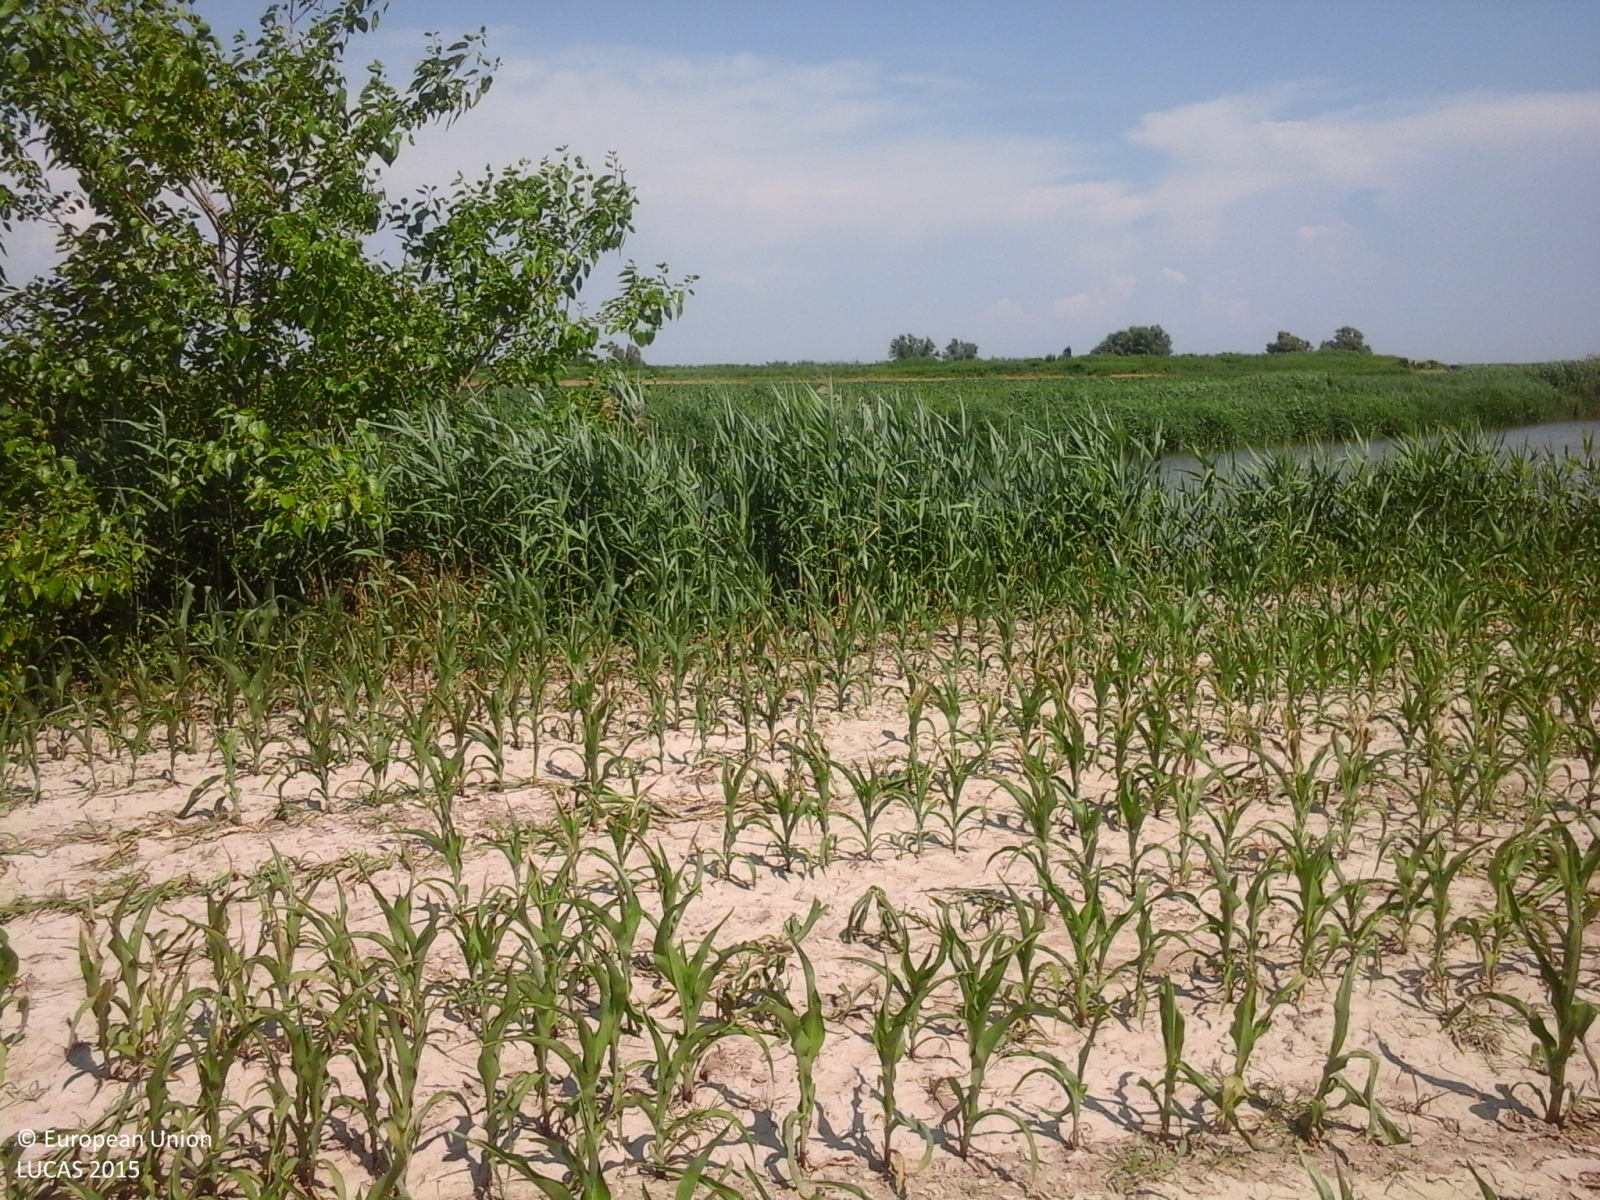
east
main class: Cropland
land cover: Maize
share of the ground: 25 - 50 %
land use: Agriculture (excluding fallow land and kitchen gardens)
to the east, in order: Maize; Inland fresh running water; Tracks; Maize; Grassland without tree/shrub cover
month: June
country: IT
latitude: 45.6613
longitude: 12.9607
